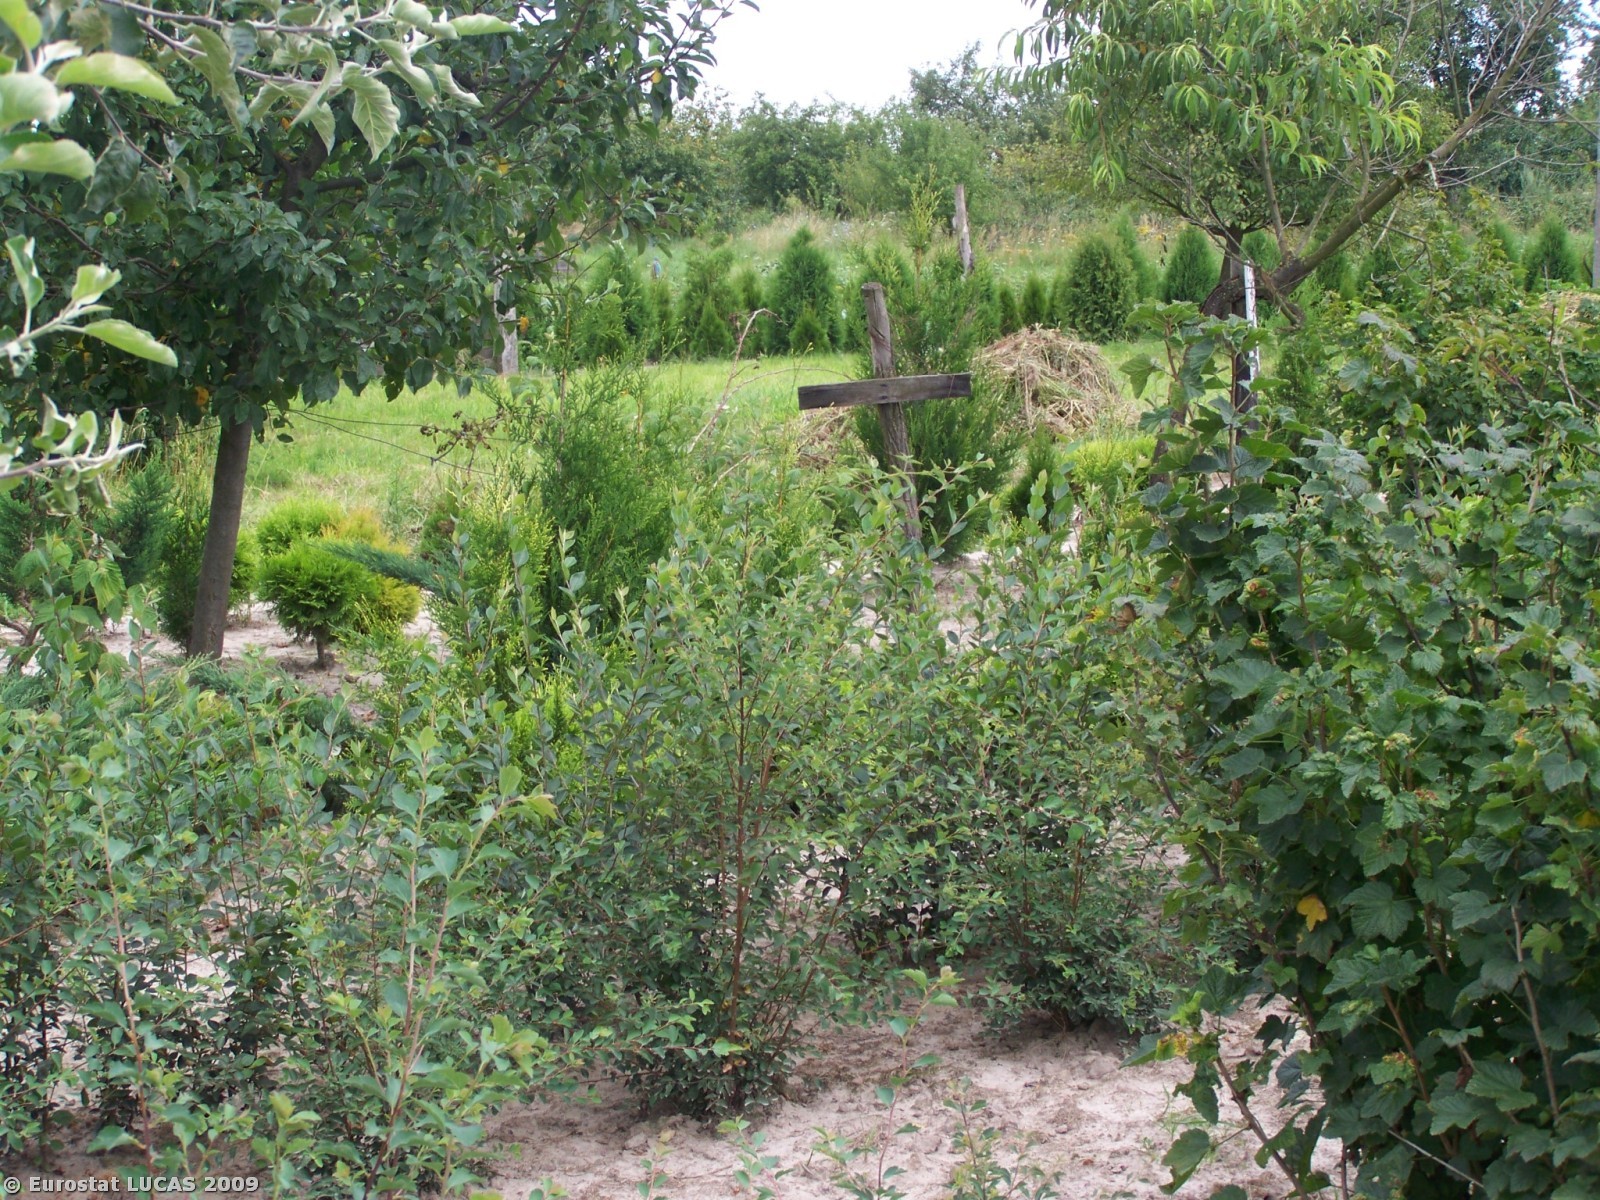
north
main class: Cropland
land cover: Other fresh vegetables
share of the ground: > 75 %
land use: Agriculture (excluding fallow land and kitchen gardens)
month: July
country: PL
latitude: 51.4345
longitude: 22.0417
